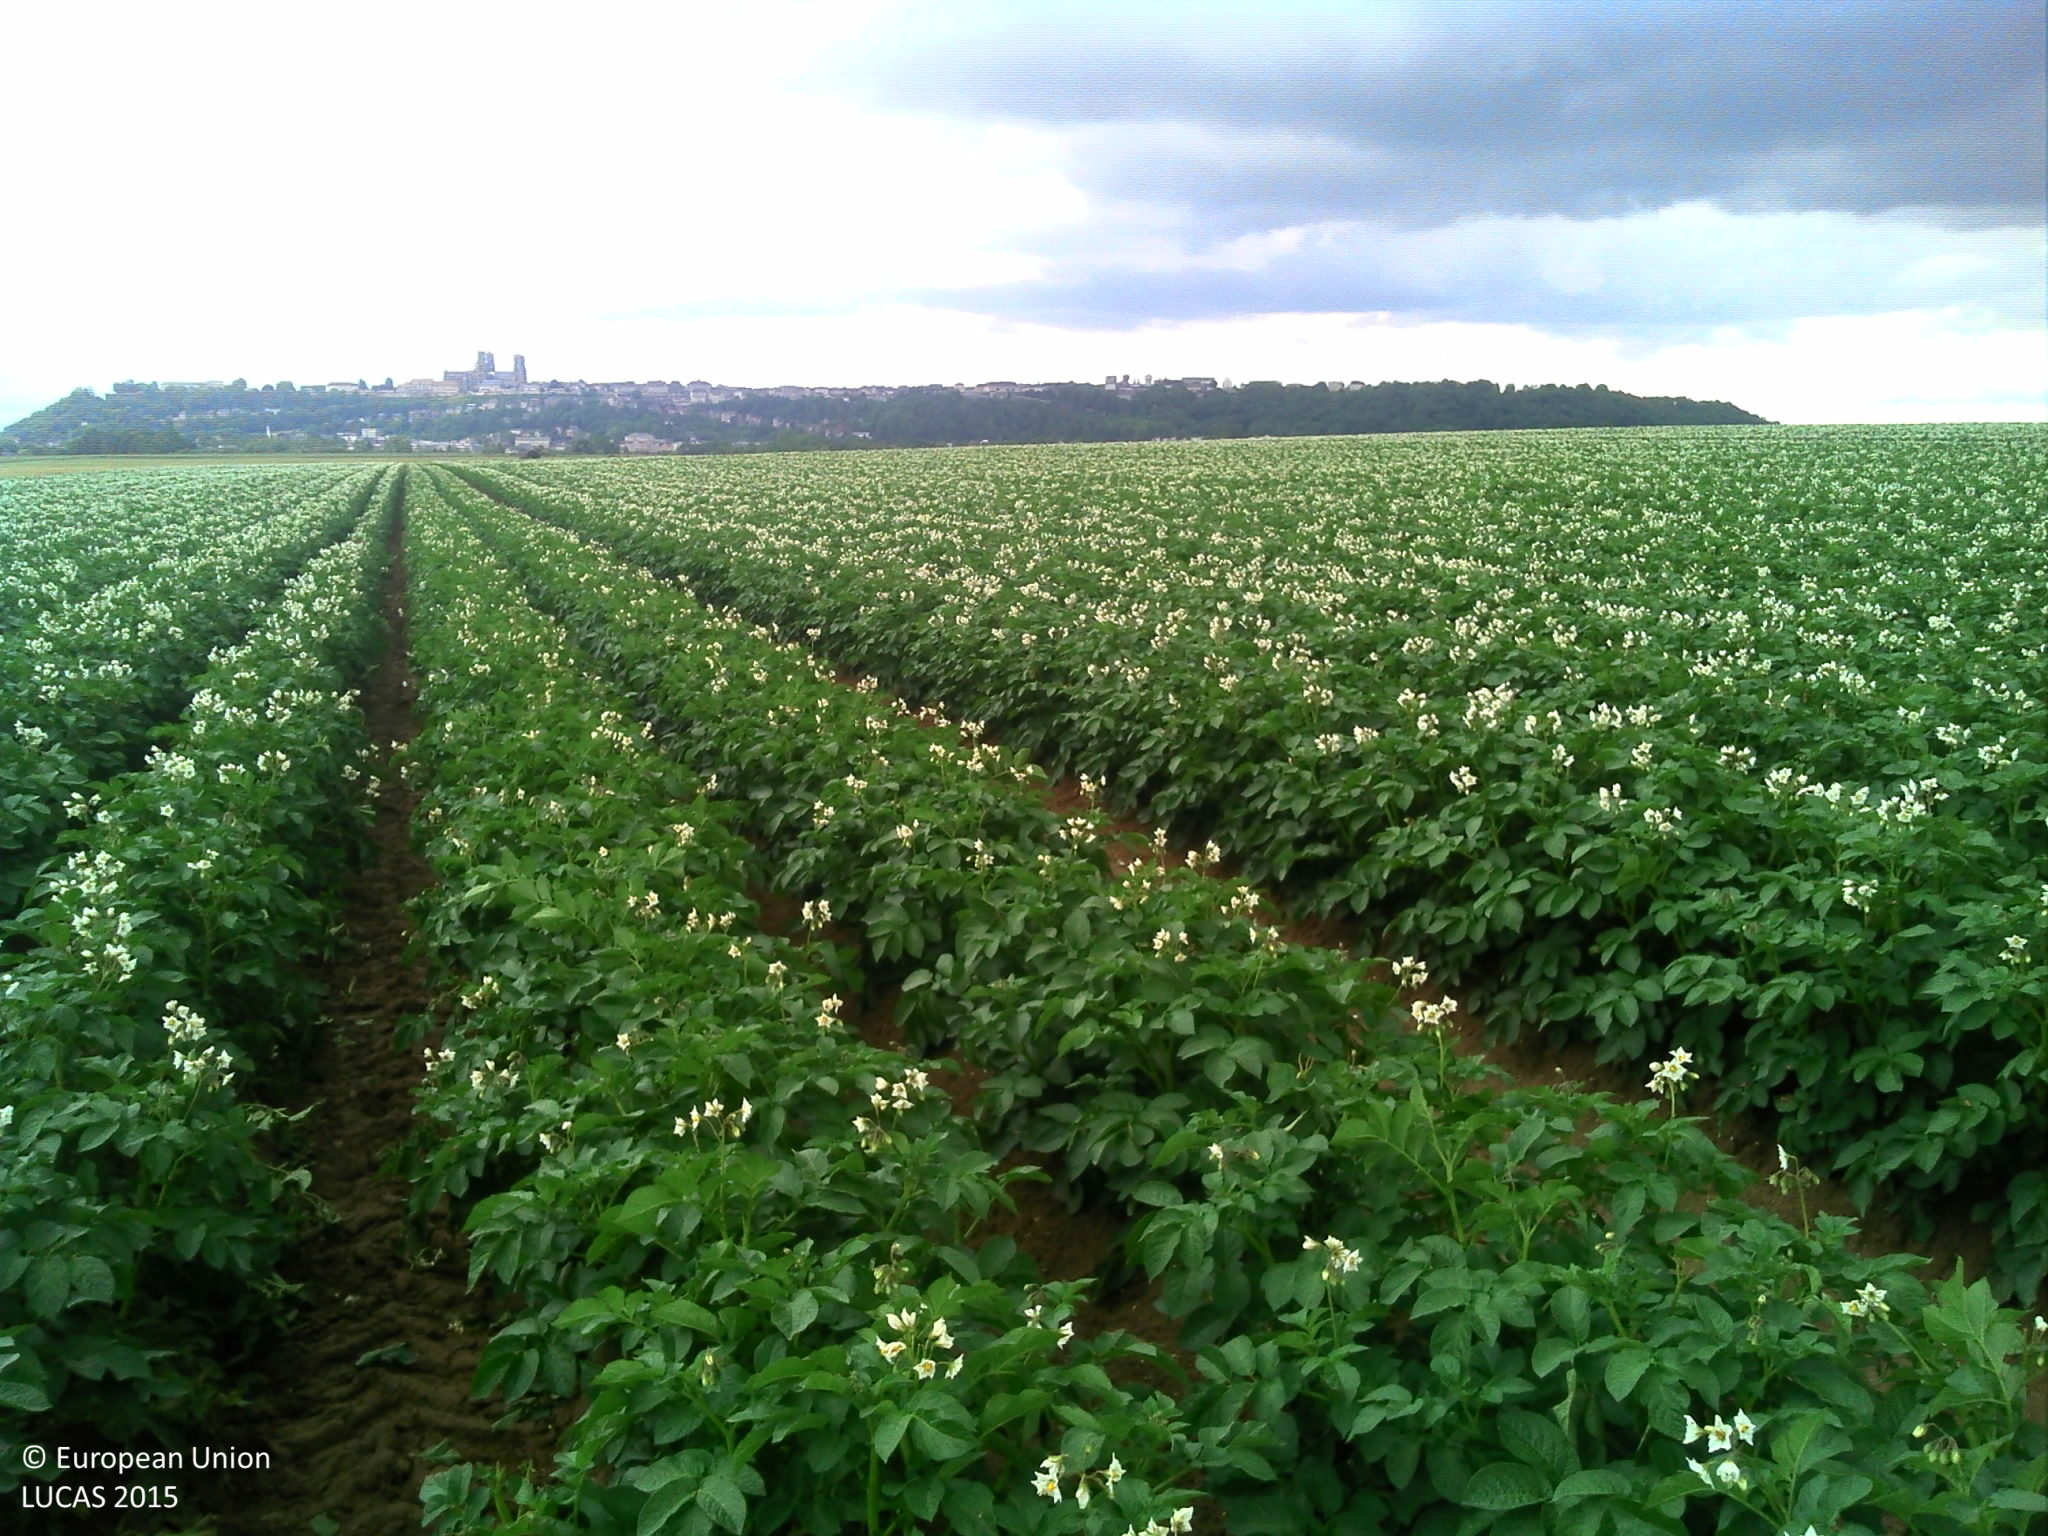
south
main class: Cropland
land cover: Potatoes
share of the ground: > 75 %
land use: Agriculture (excluding fallow land and kitchen gardens)
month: June
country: FR
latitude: 49.5904
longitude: 3.6159
